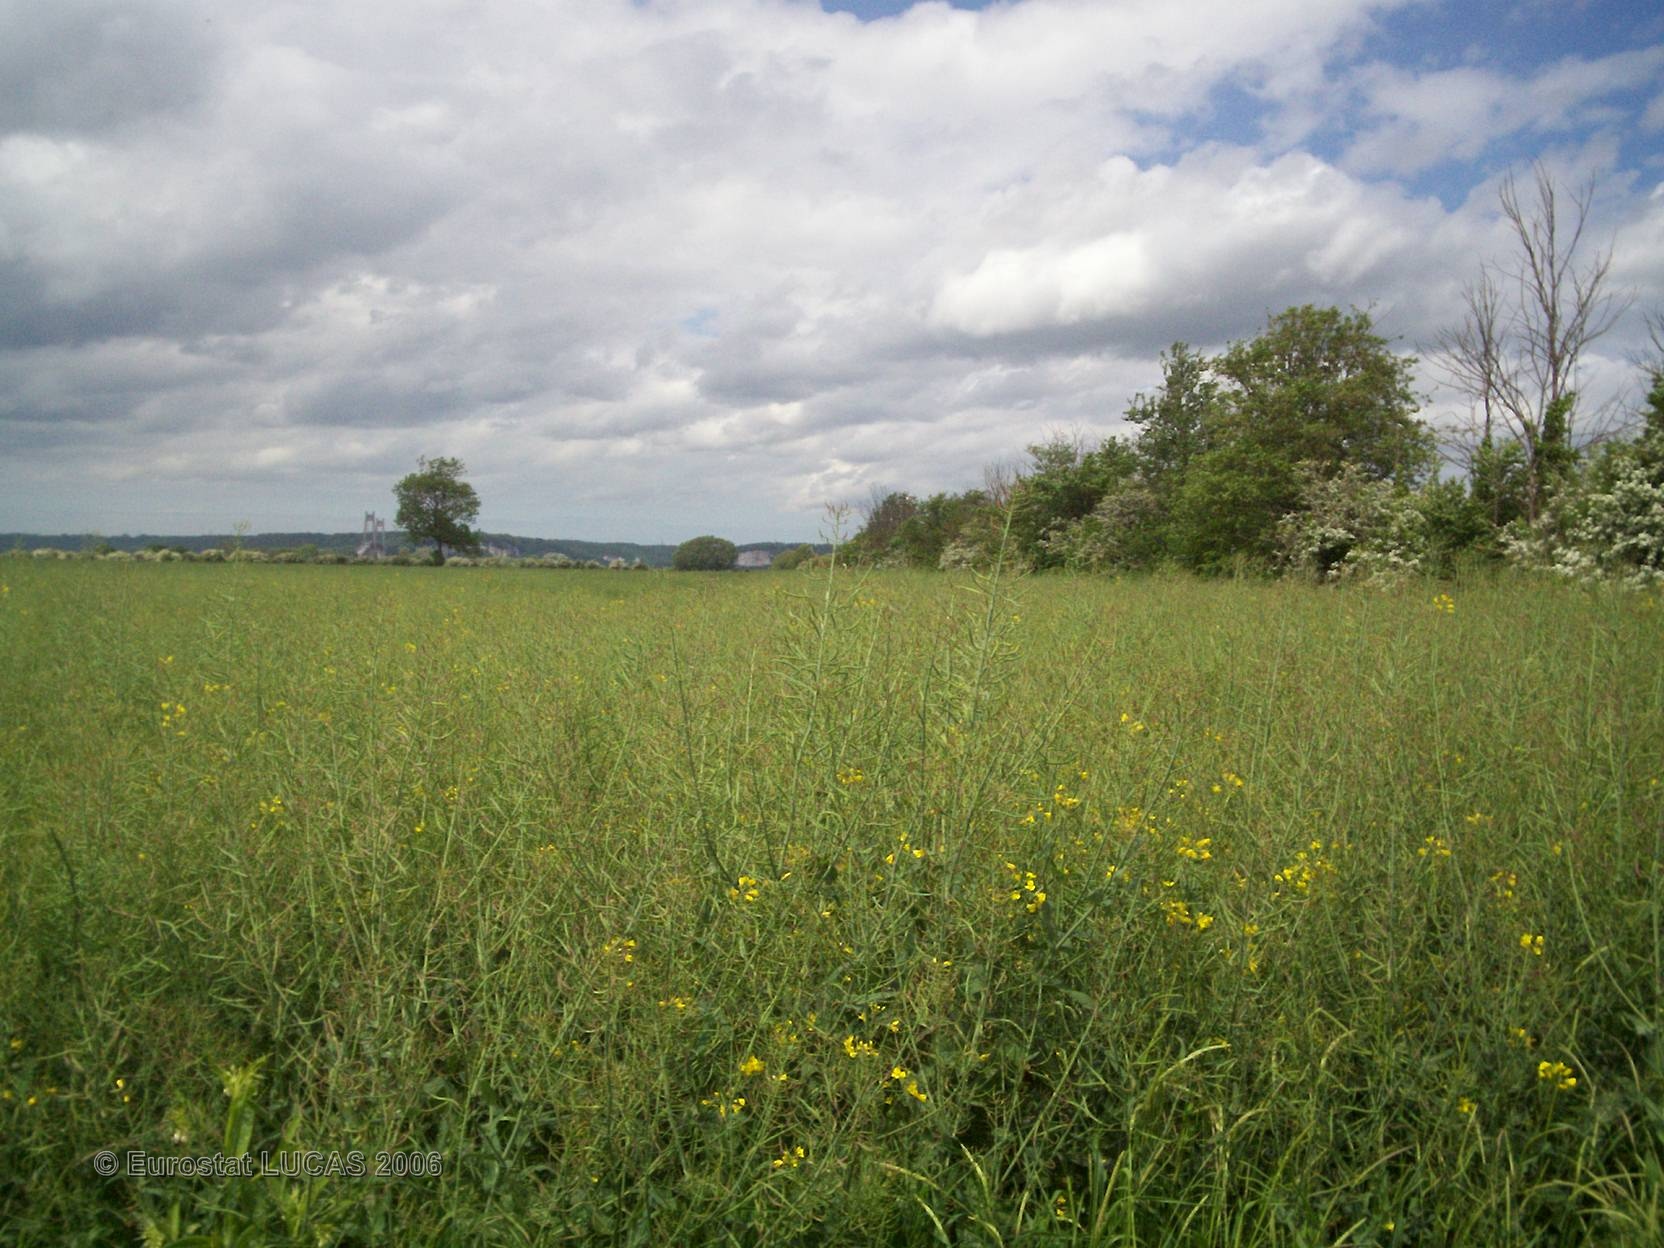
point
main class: Cropland
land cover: Rape and turnip rape
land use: Agriculture (excluding fallow land and kitchen gardens)
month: May
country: FR
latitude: 49.4425
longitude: 0.4984
